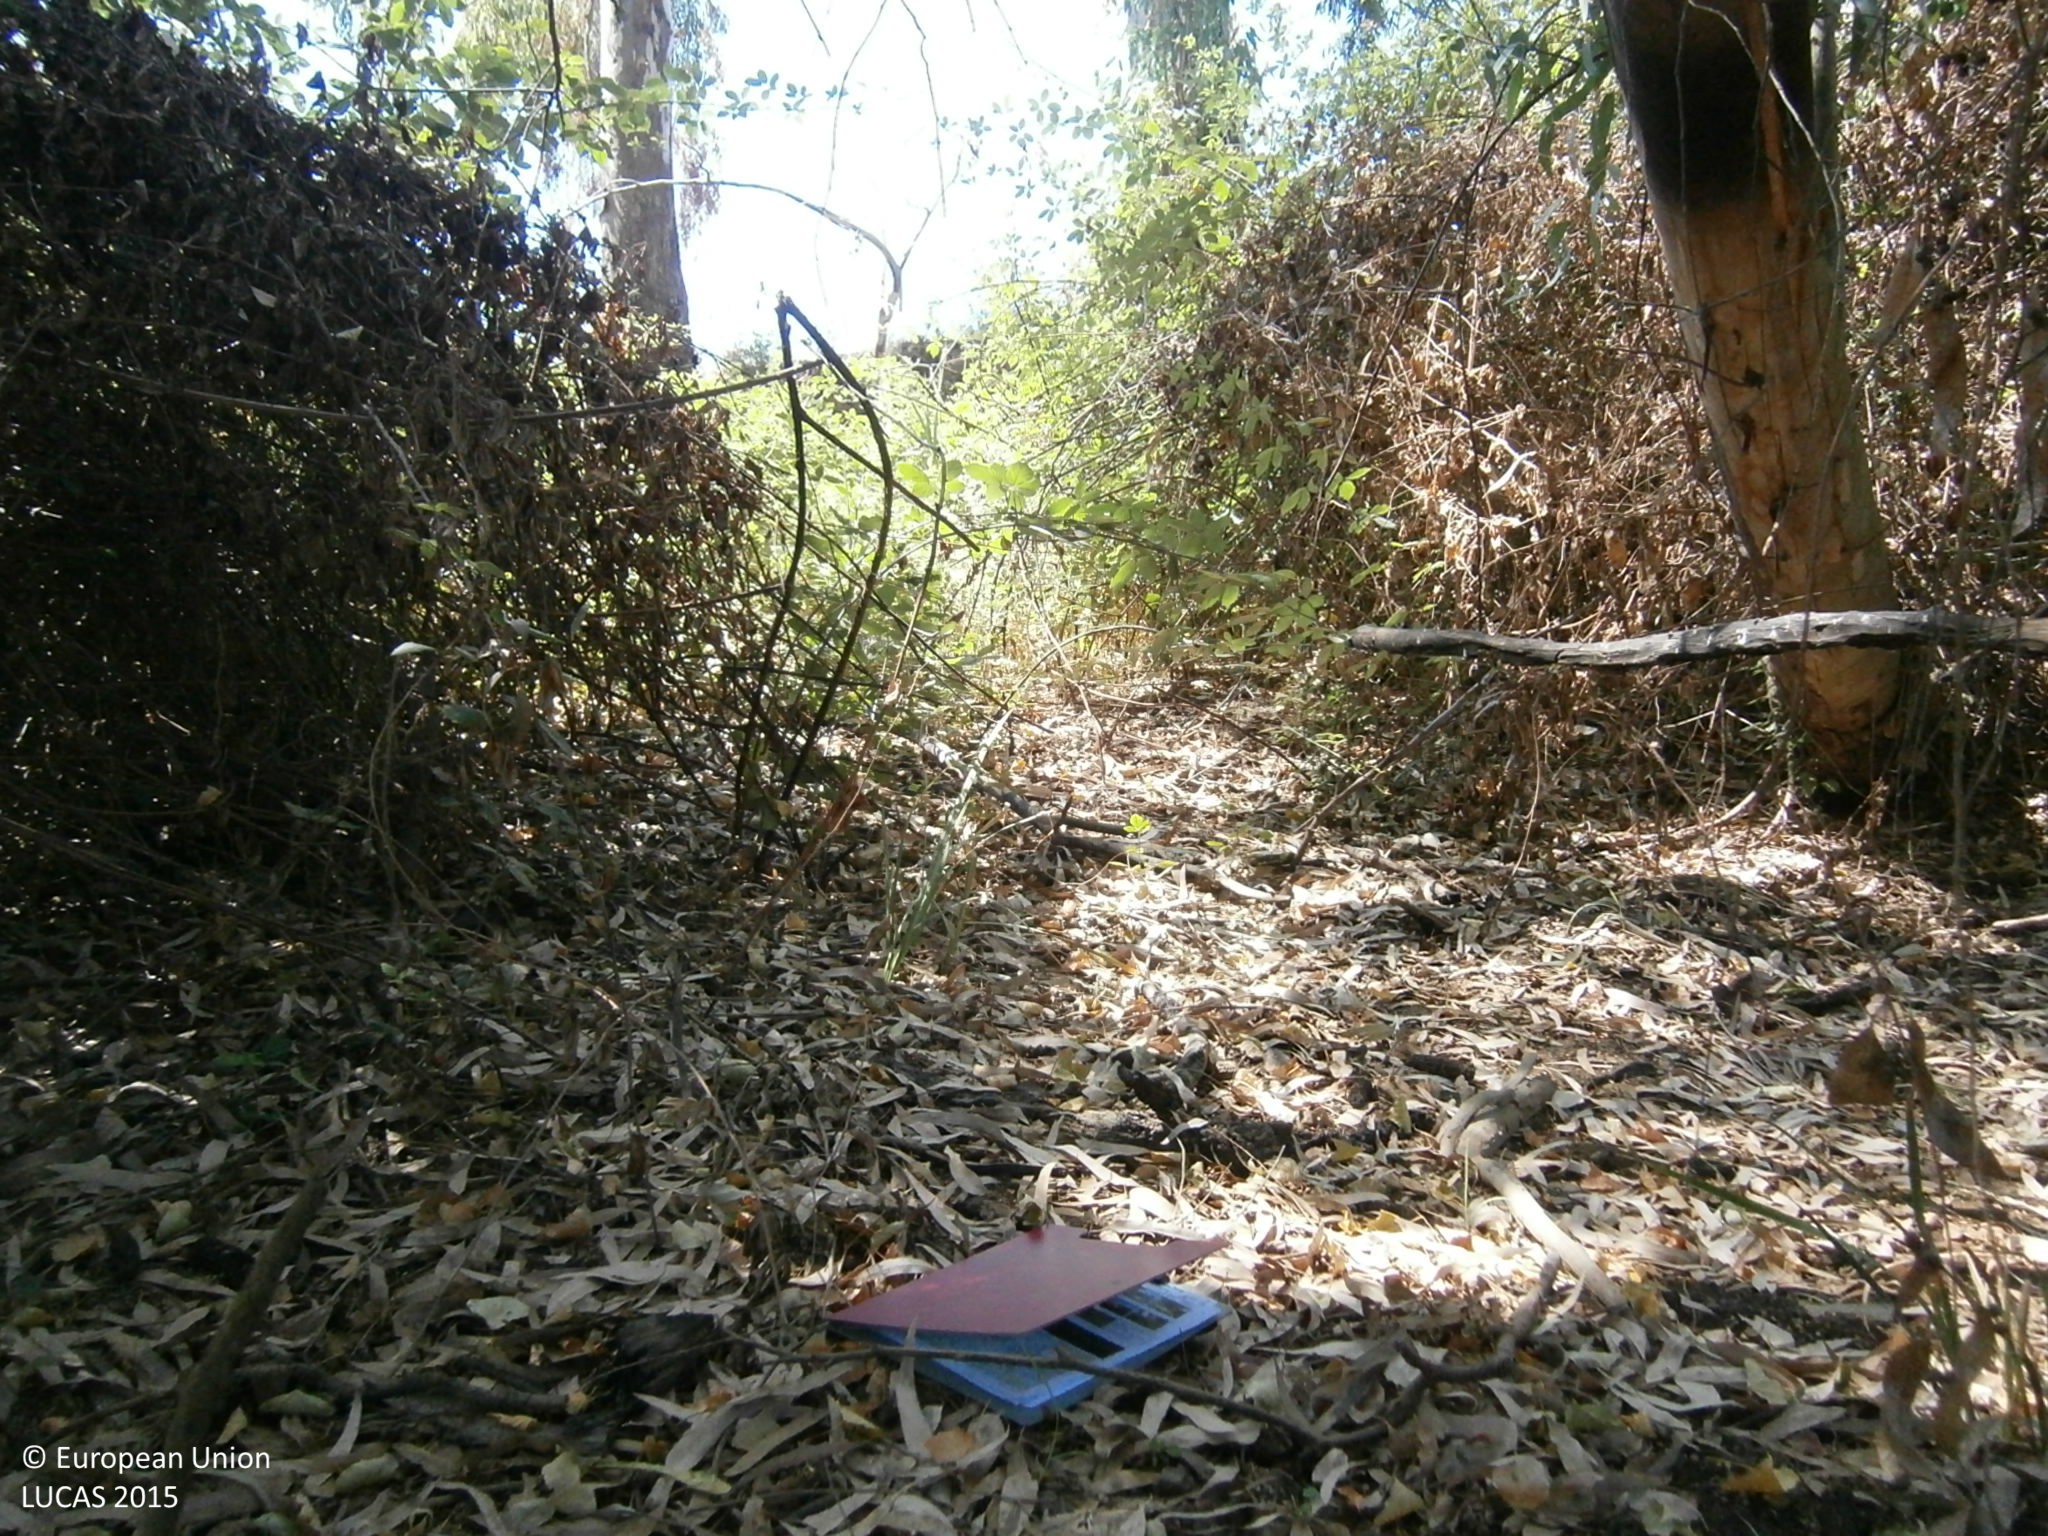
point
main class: Woodland
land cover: Other mixed woodland
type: boreal forest
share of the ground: > 75 %
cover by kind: broadleaved forest trees 35 %, shrubs 30 %, coniferous forest trees 15 %, herbaceous plants 10 %
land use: Forestry
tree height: > 5 m
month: July
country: ES
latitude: 38.9309
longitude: -6.8288
